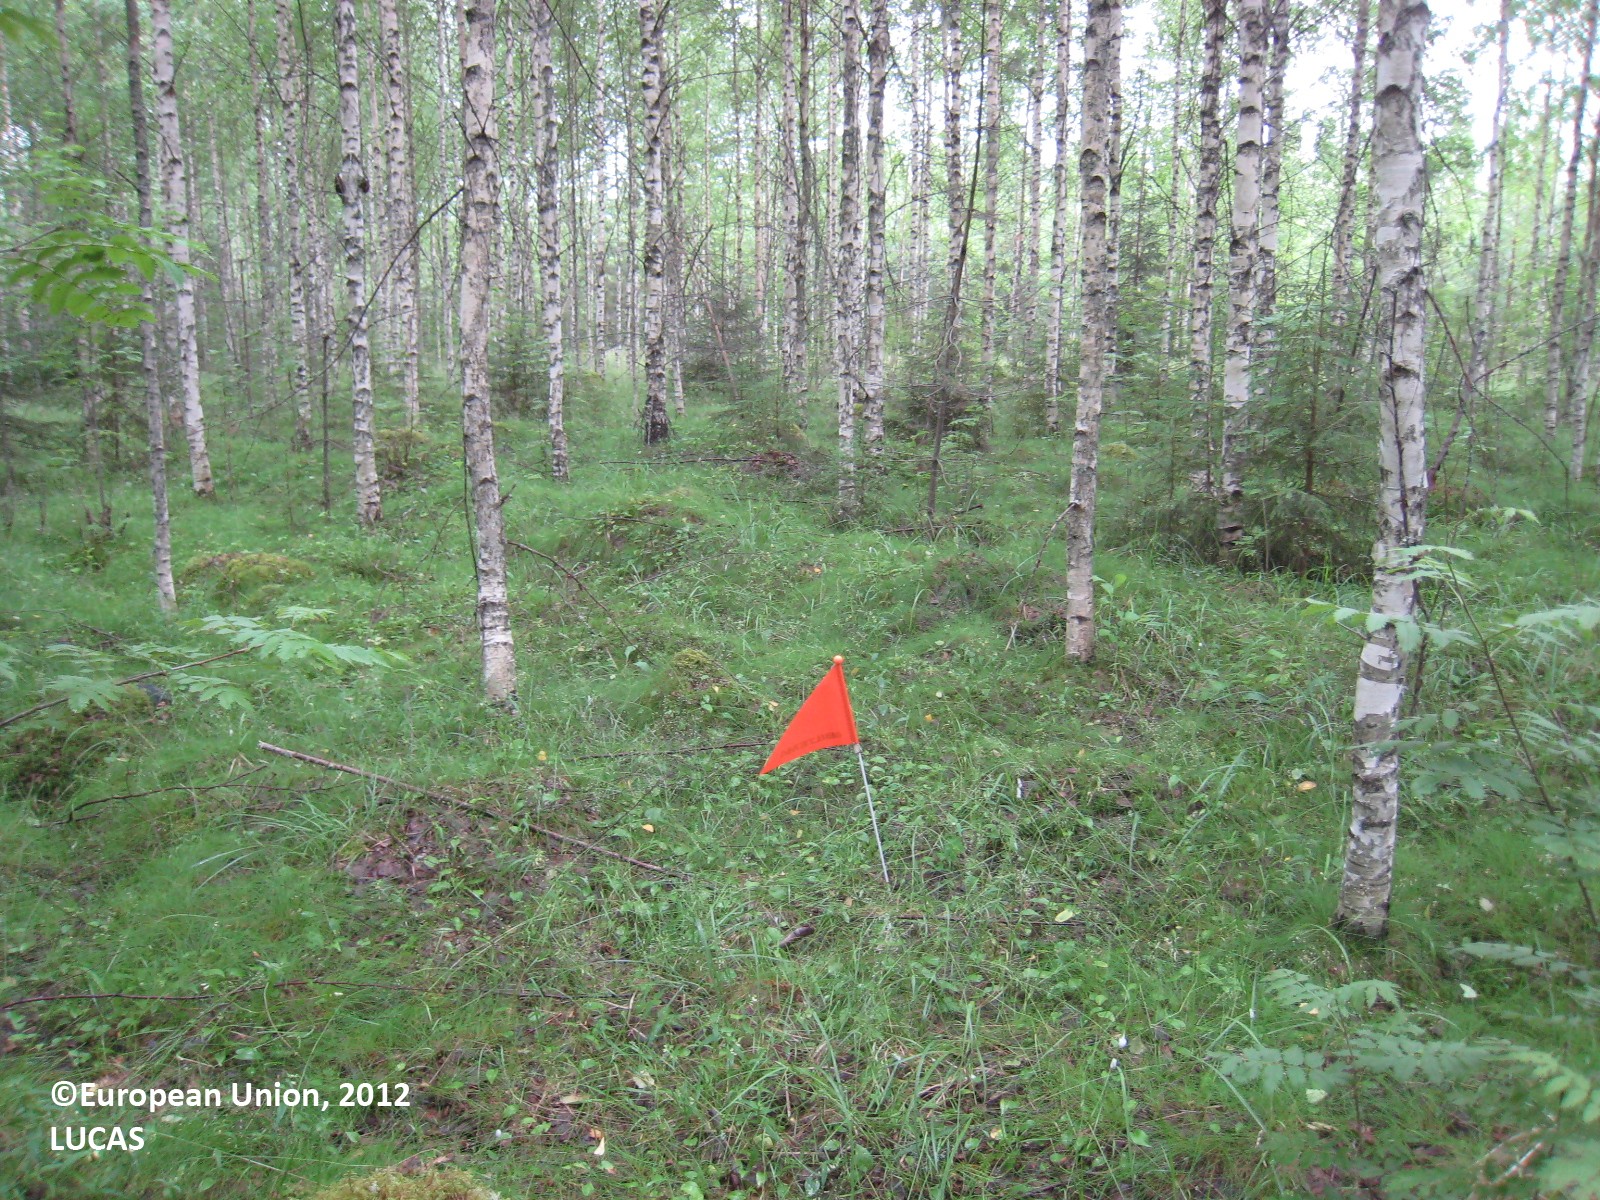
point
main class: Woodland
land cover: Broadleaved woodland
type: non-riverine alder, birch or aspen forest
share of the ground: > 75 %
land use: Forestry
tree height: > 5 m
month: July
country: FI
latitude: 61.7415
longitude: 27.3430
